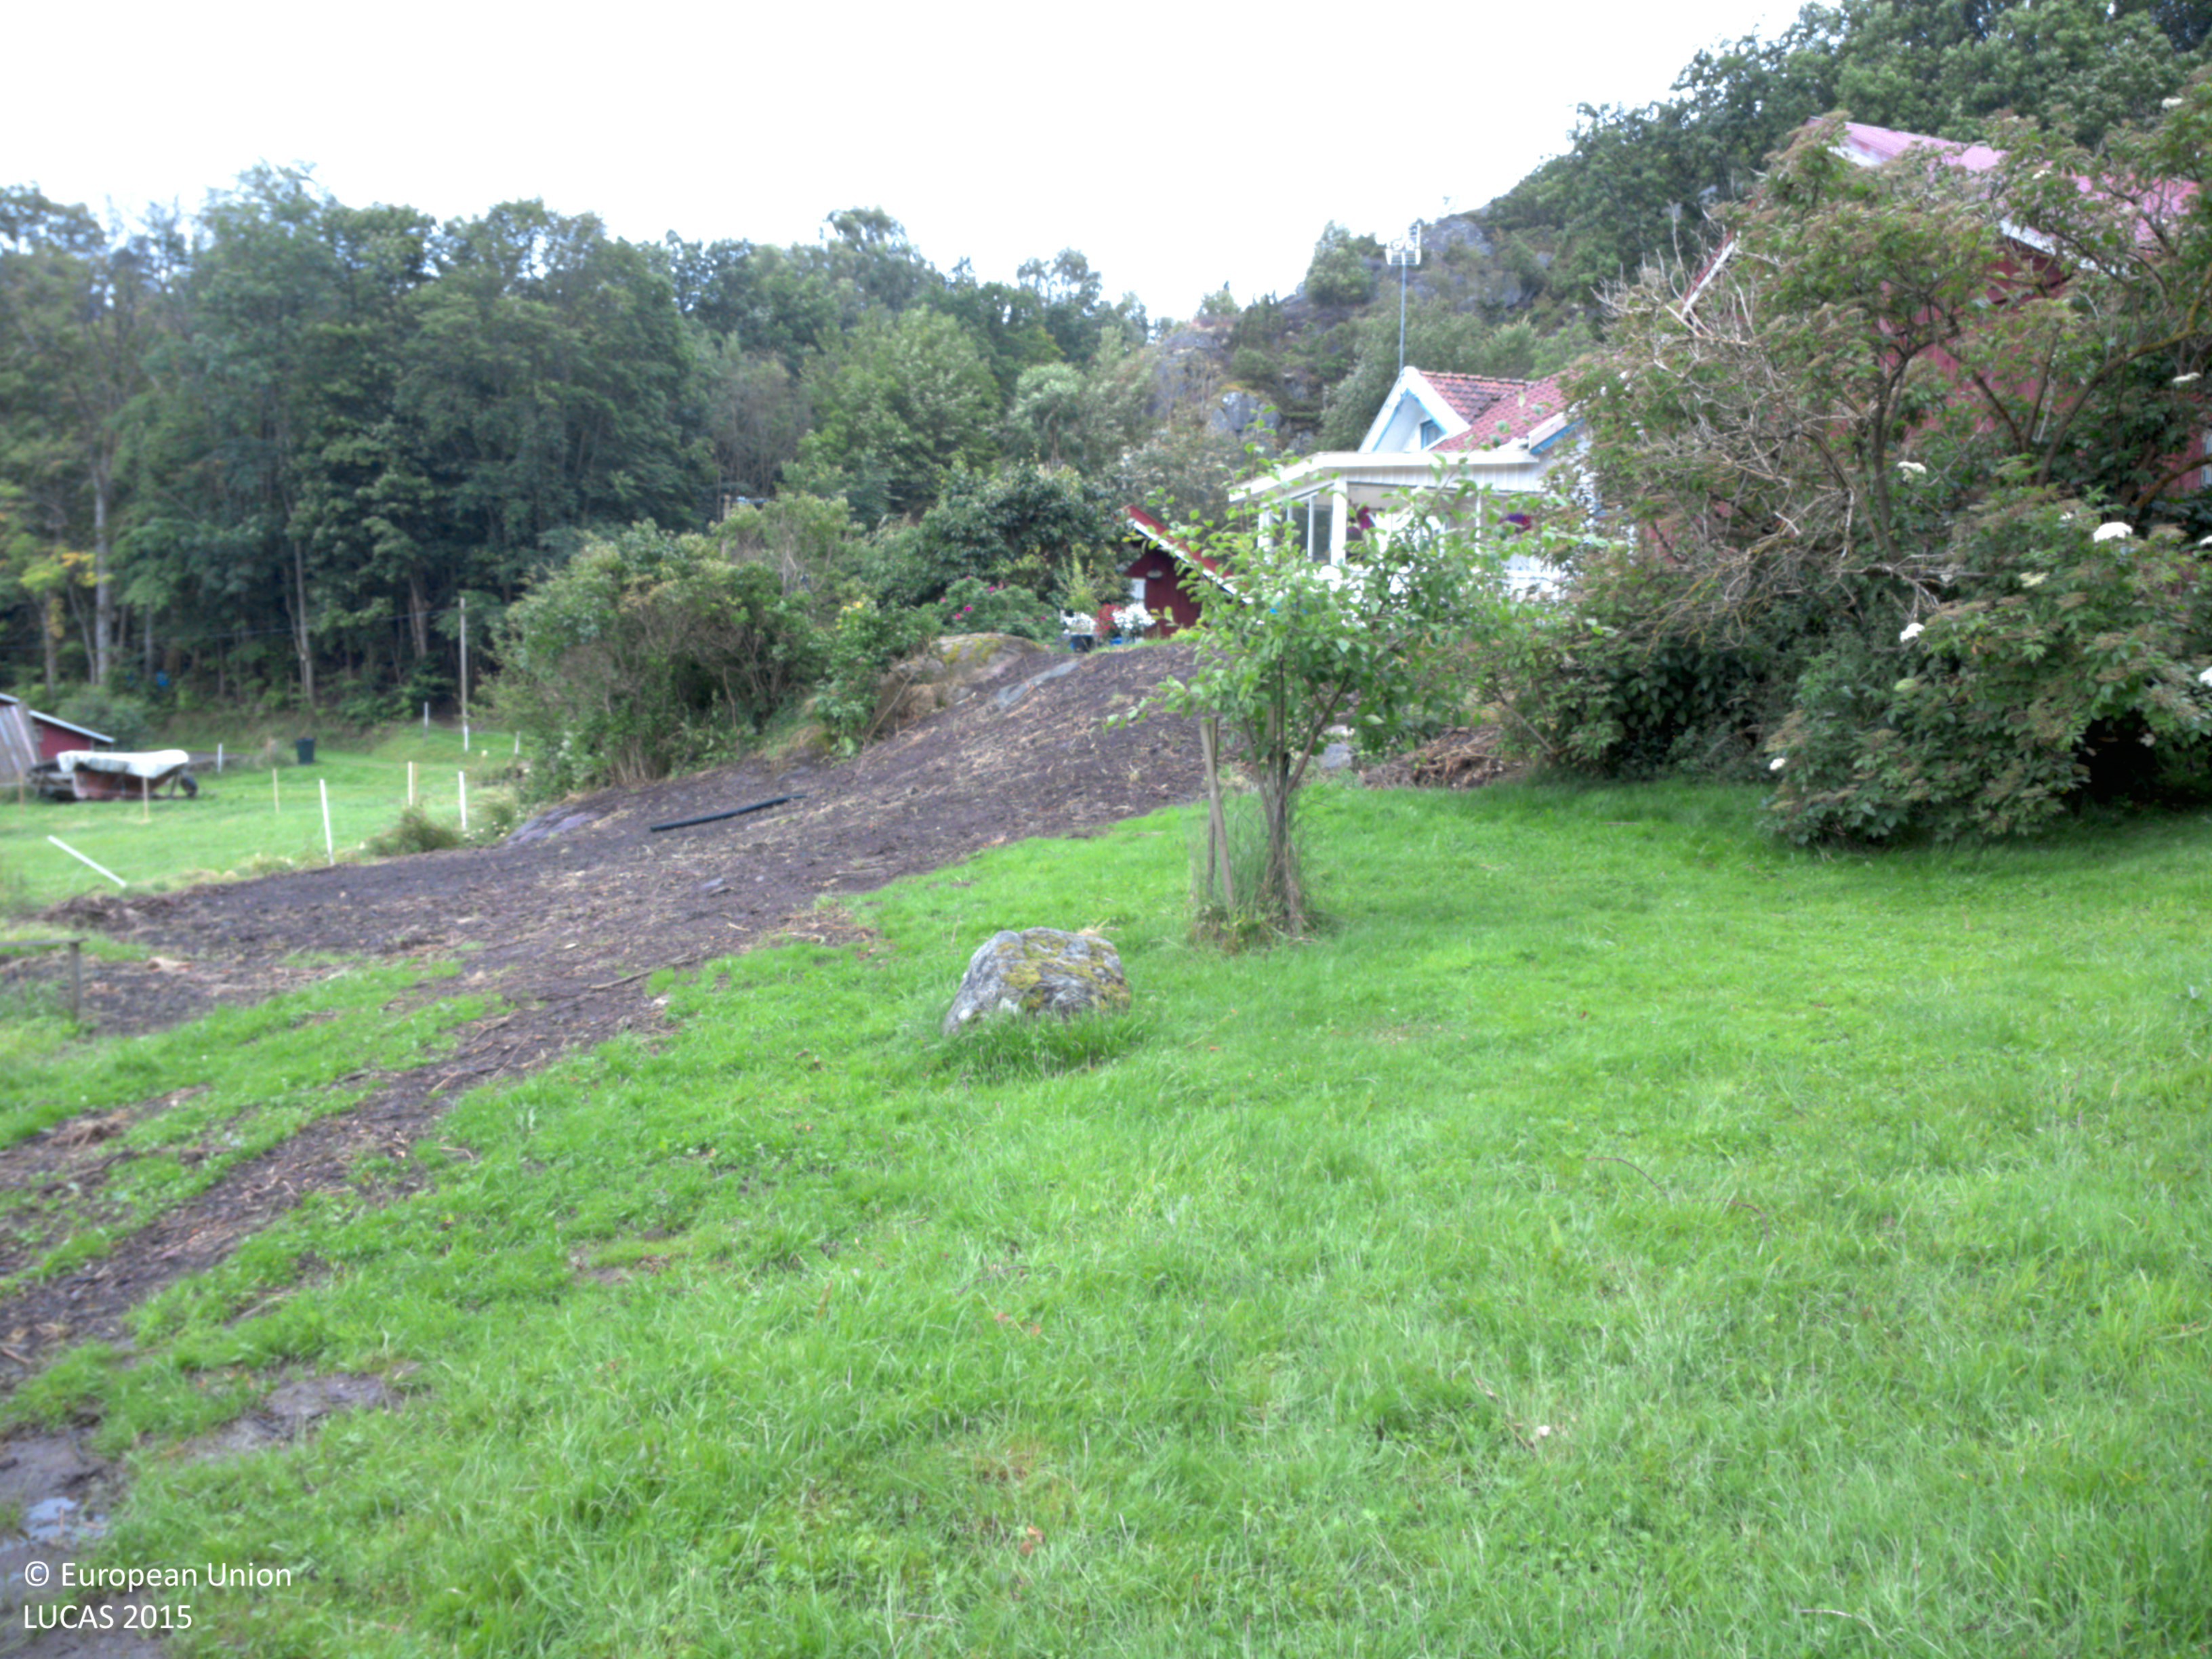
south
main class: Grassland
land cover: Grassland without tree/shrub cover
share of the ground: > 75 %
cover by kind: herbaceous plants 90 %, unconsolidated bare surface 10 %
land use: Residential
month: July
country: SE
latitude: 58.0484
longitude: 11.5726
